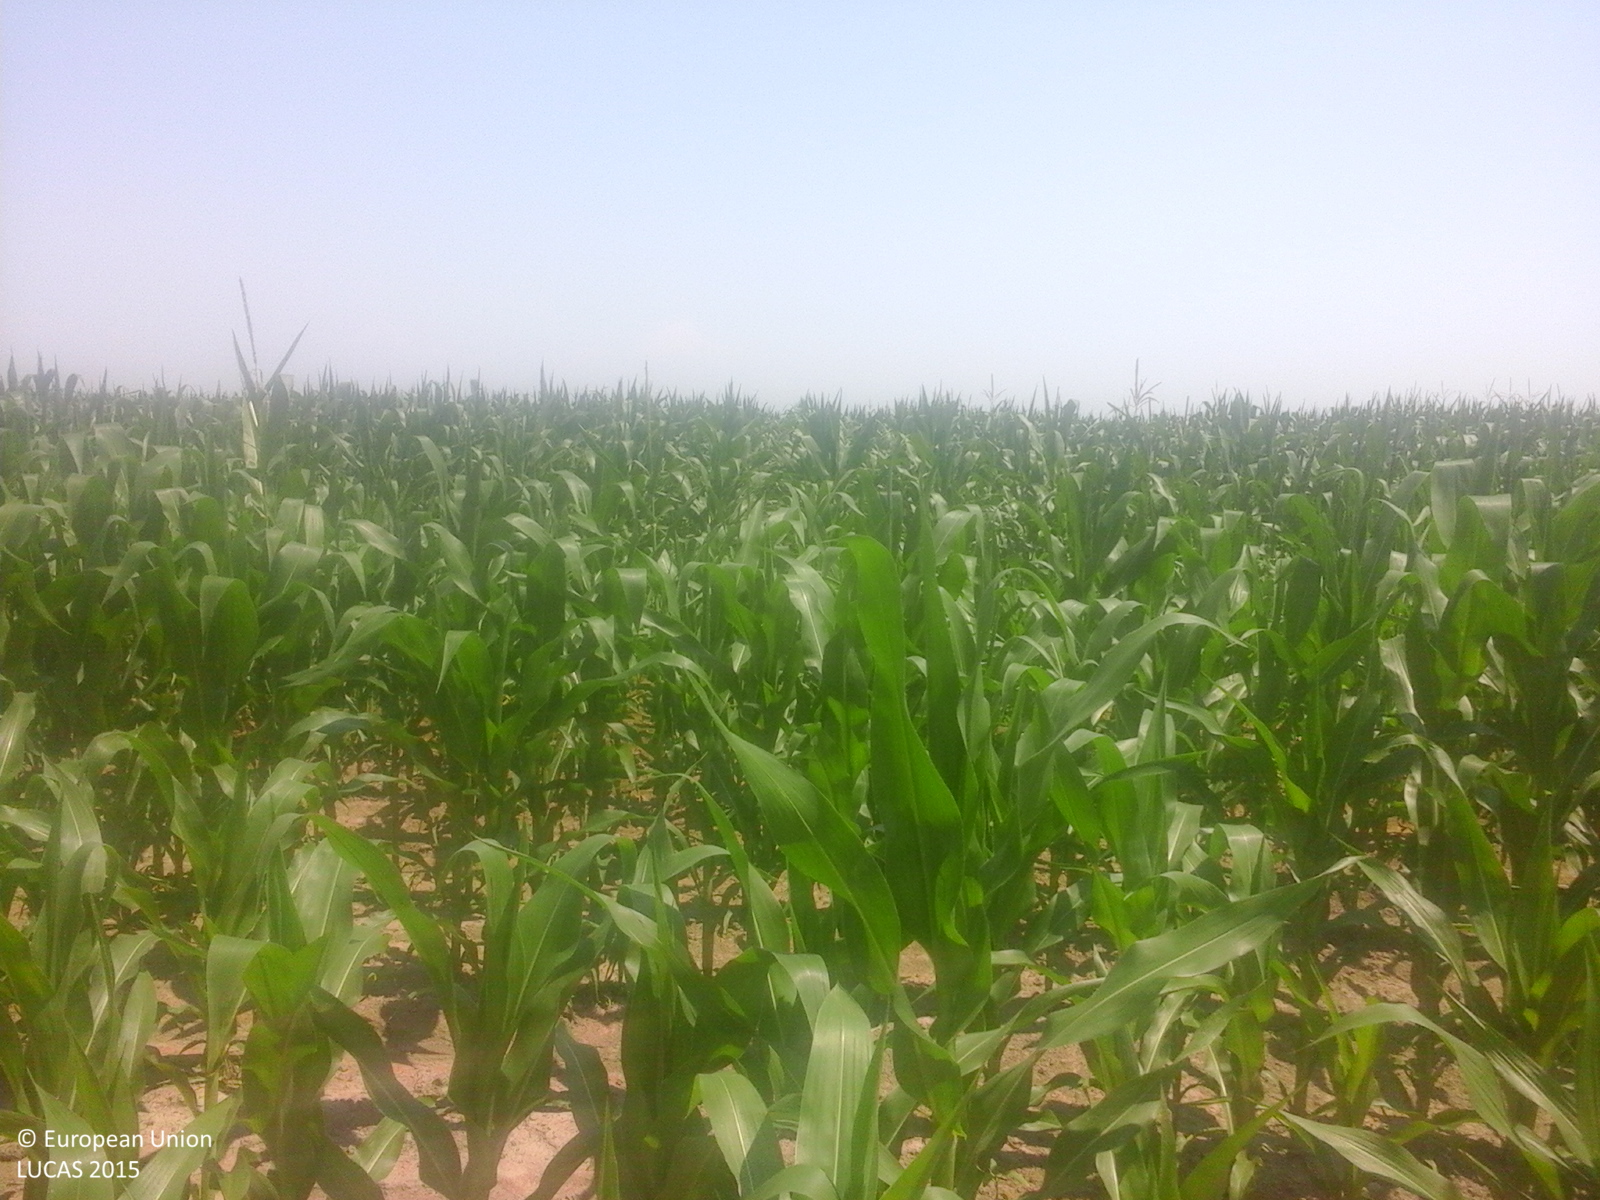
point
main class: Cropland
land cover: Maize
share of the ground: > 75 %
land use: Agriculture (excluding fallow land and kitchen gardens)
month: July
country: RO
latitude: 44.7194
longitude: 24.9923
